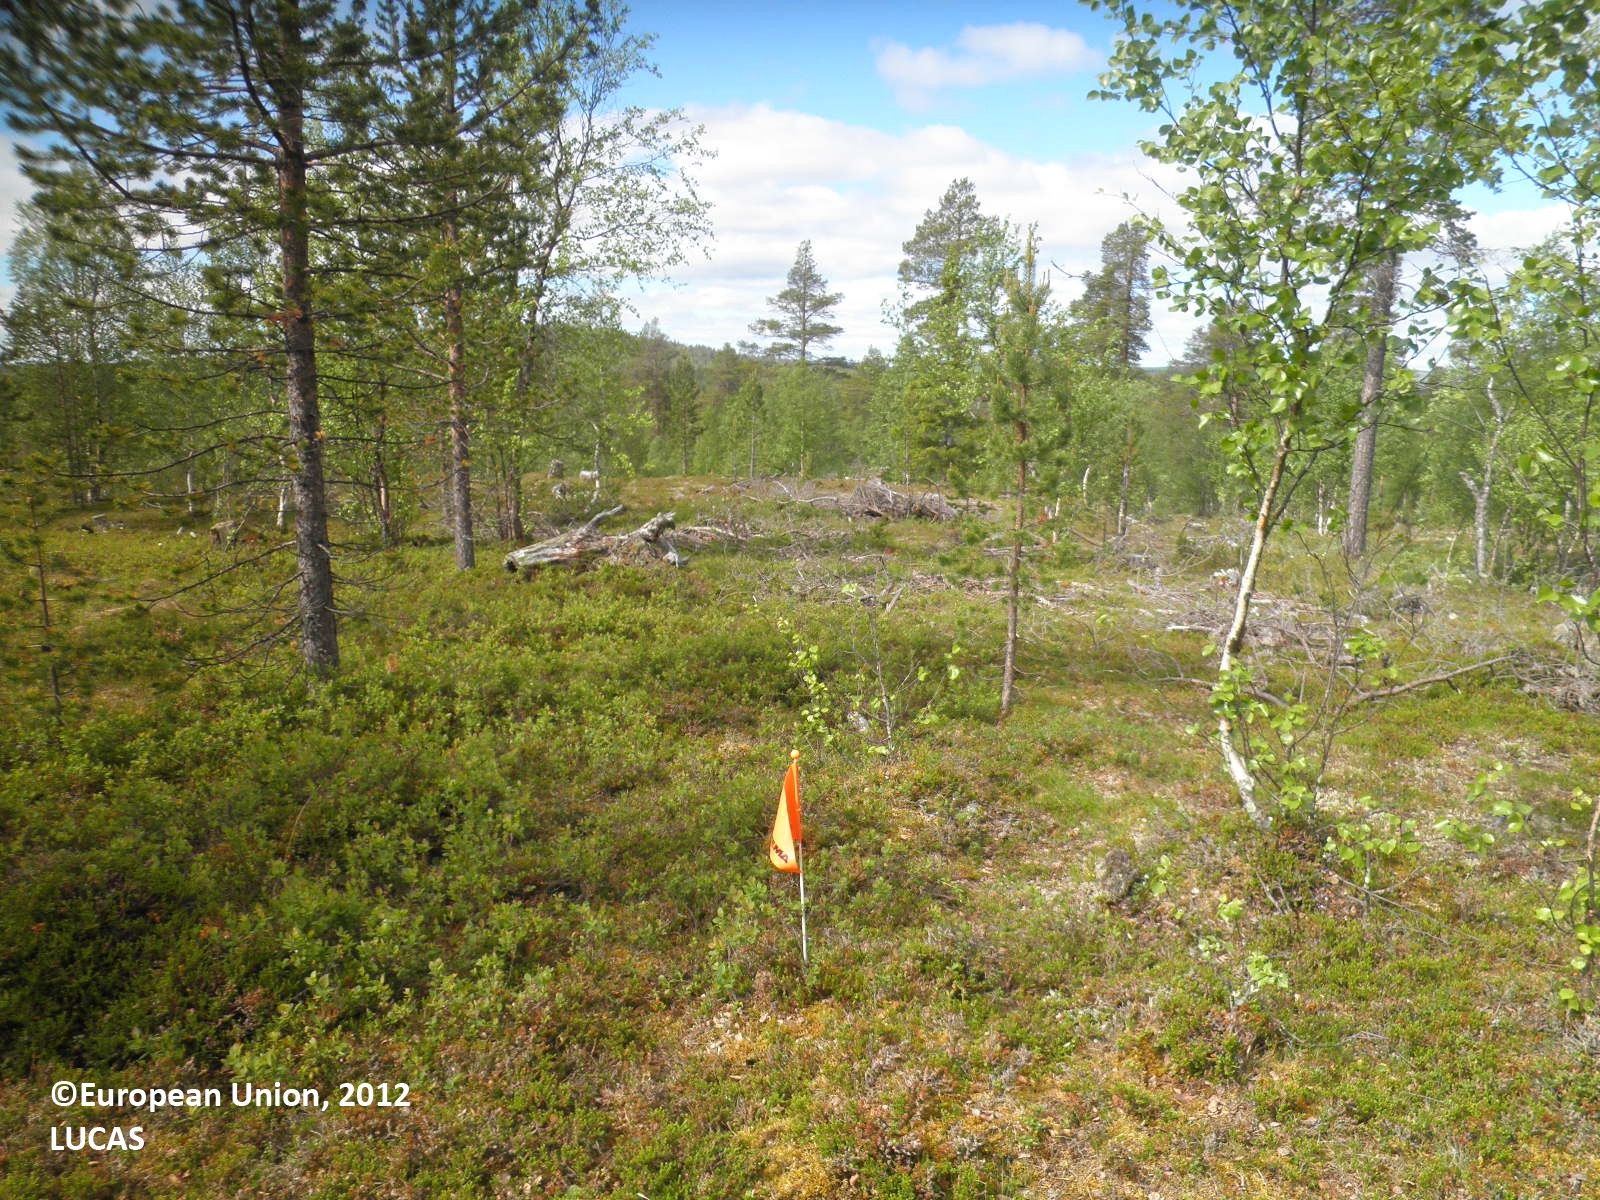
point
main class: Woodland
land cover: Pine dominated mixed woodland
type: boreal forest
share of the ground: 25 - 50 %
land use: Forestry
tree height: > 5 m
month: July
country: FI
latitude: 68.6567
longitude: 26.3216
